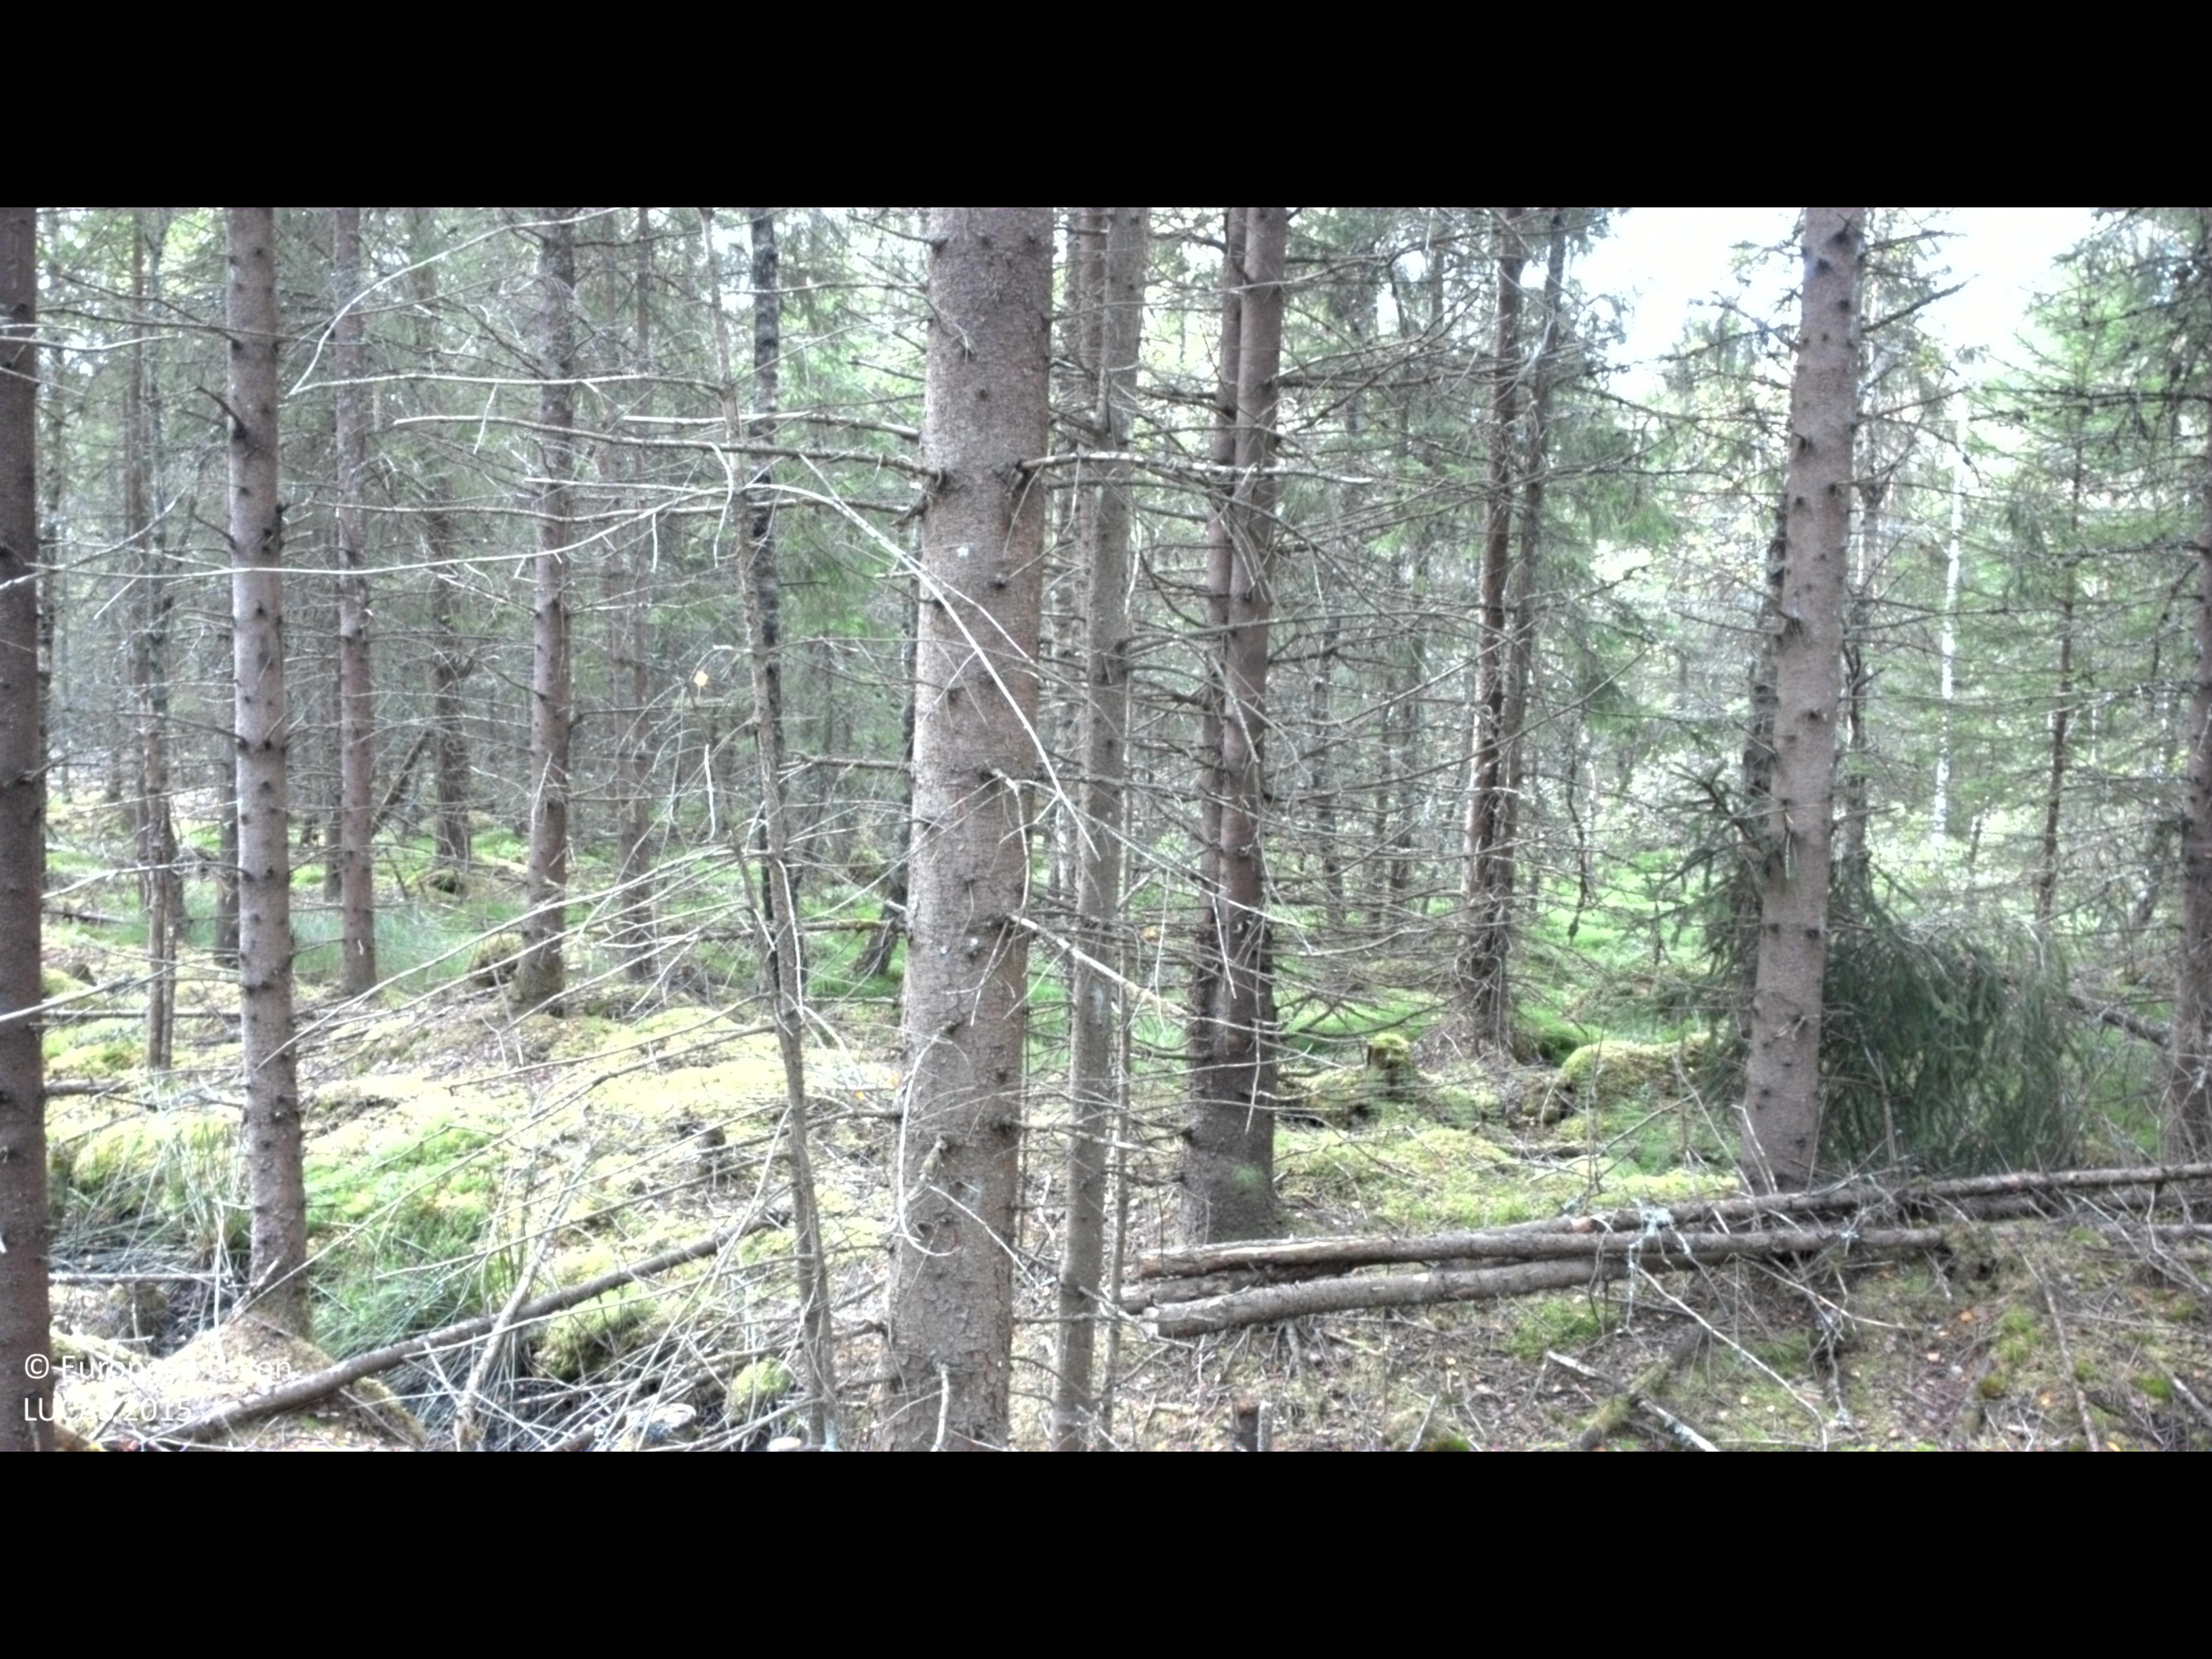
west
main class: Woodland
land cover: Spruce dominated coniferous woodland
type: boreal forest
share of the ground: 50 - 75 %
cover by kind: coniferous forest trees 60 %, shrubs 20 %, broadleaved forest trees 15 %, herbaceous plants 5 %
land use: Forestry
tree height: > 5 m
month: August
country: SE
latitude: 57.1731
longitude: 13.8828
